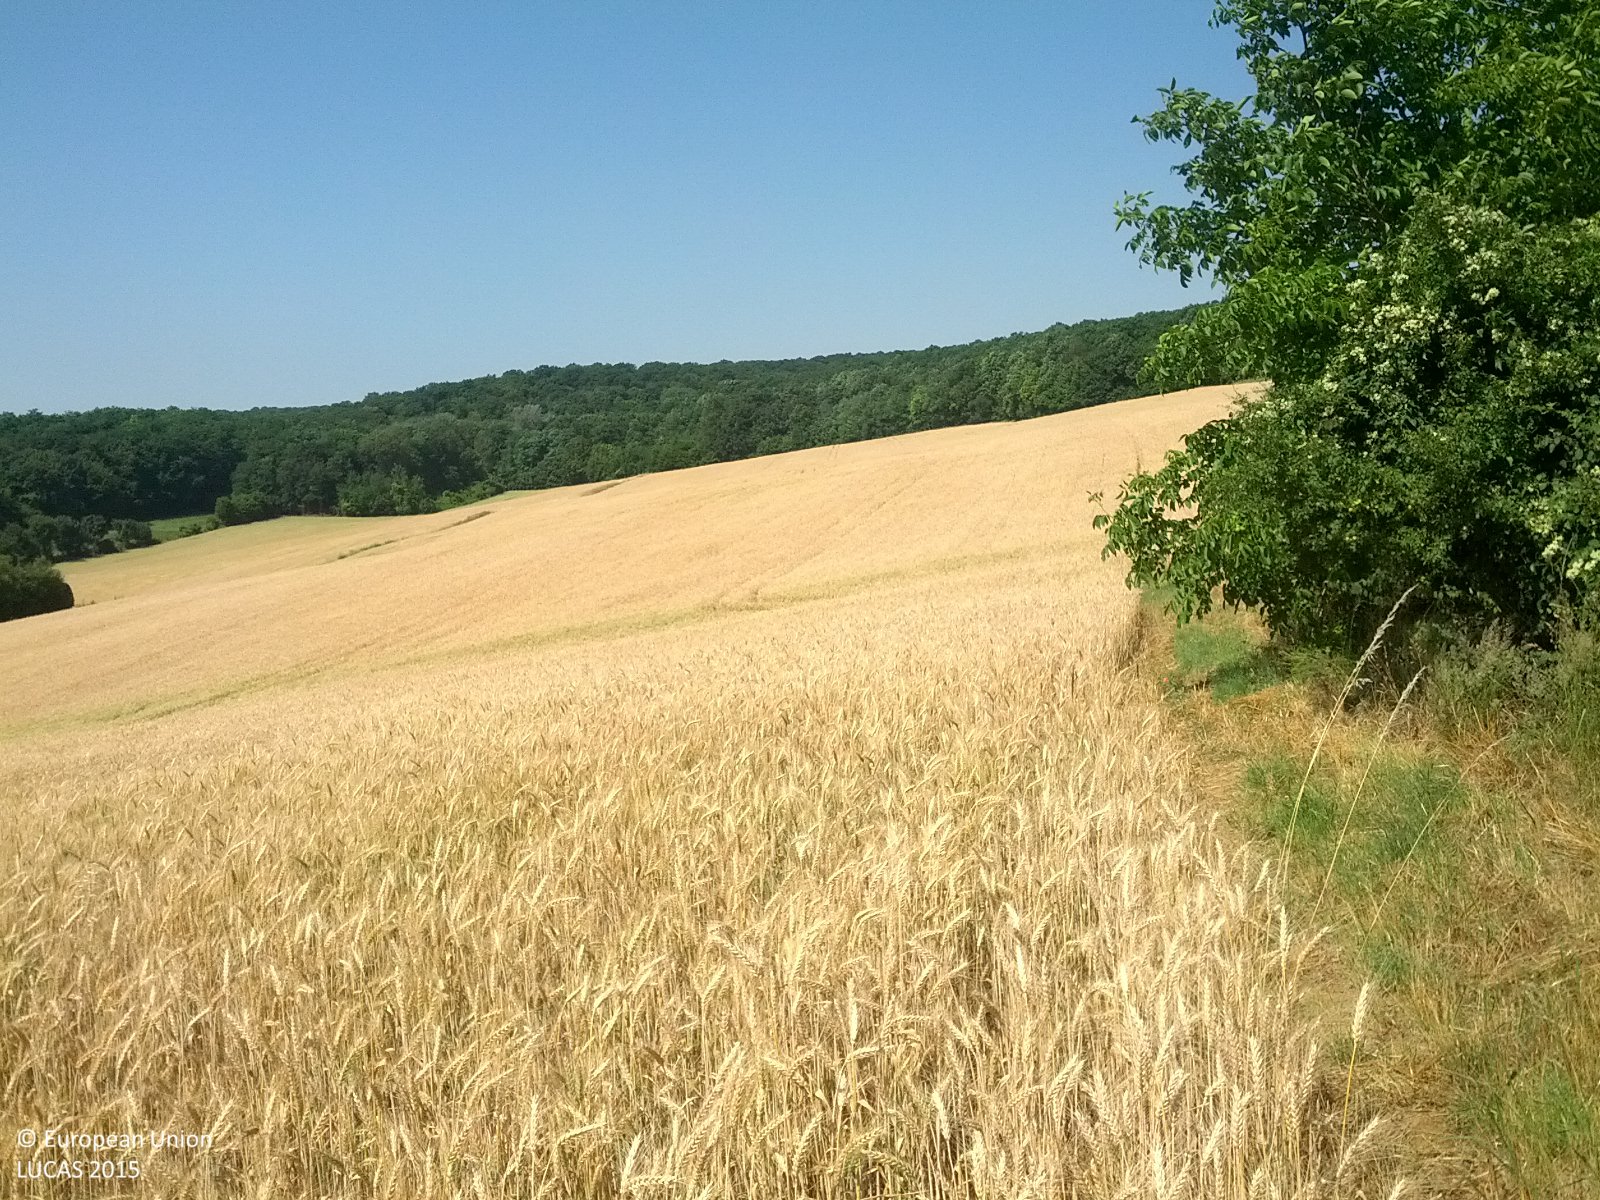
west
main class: Cropland
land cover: Common wheat
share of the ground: > 75 %
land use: Agriculture (excluding fallow land and kitchen gardens)
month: July
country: AT
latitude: 48.6270
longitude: 16.5052
